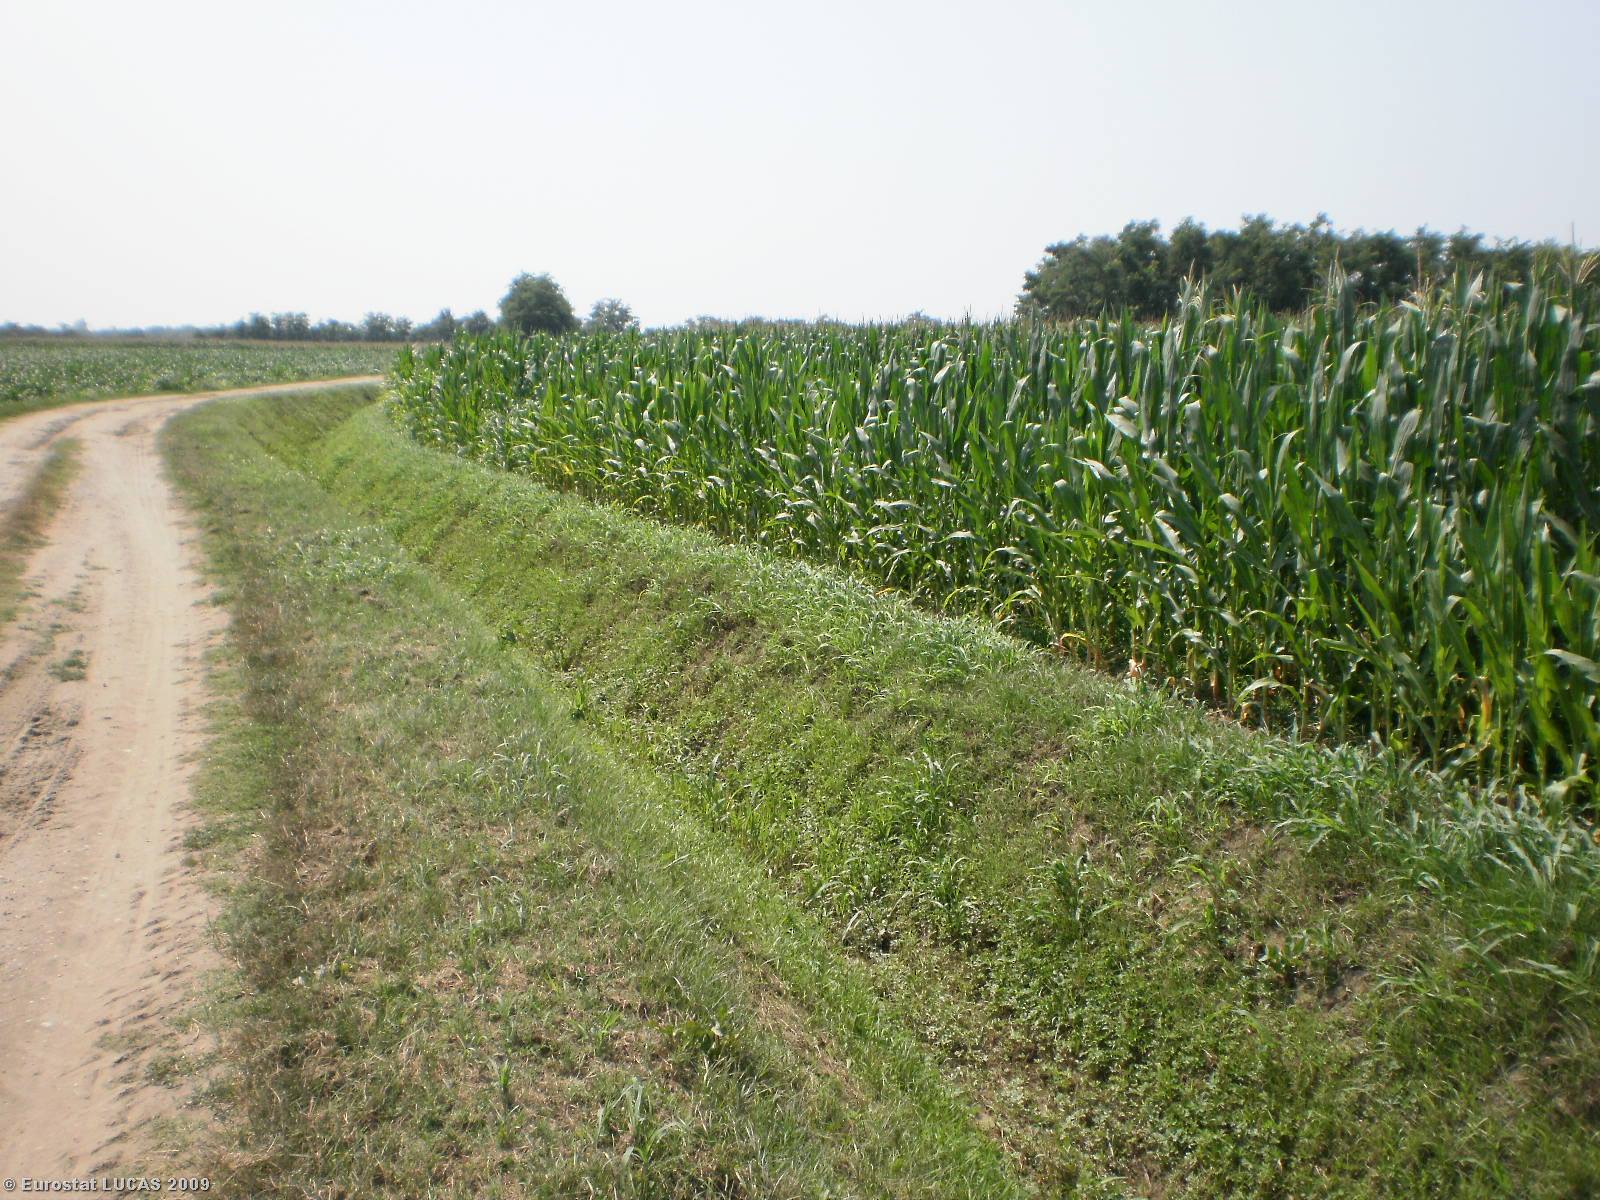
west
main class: Cropland
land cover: Maize
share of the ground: > 75 %
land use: Agriculture (excluding fallow land and kitchen gardens)
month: June
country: IT
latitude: 45.2701
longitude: 10.0382
